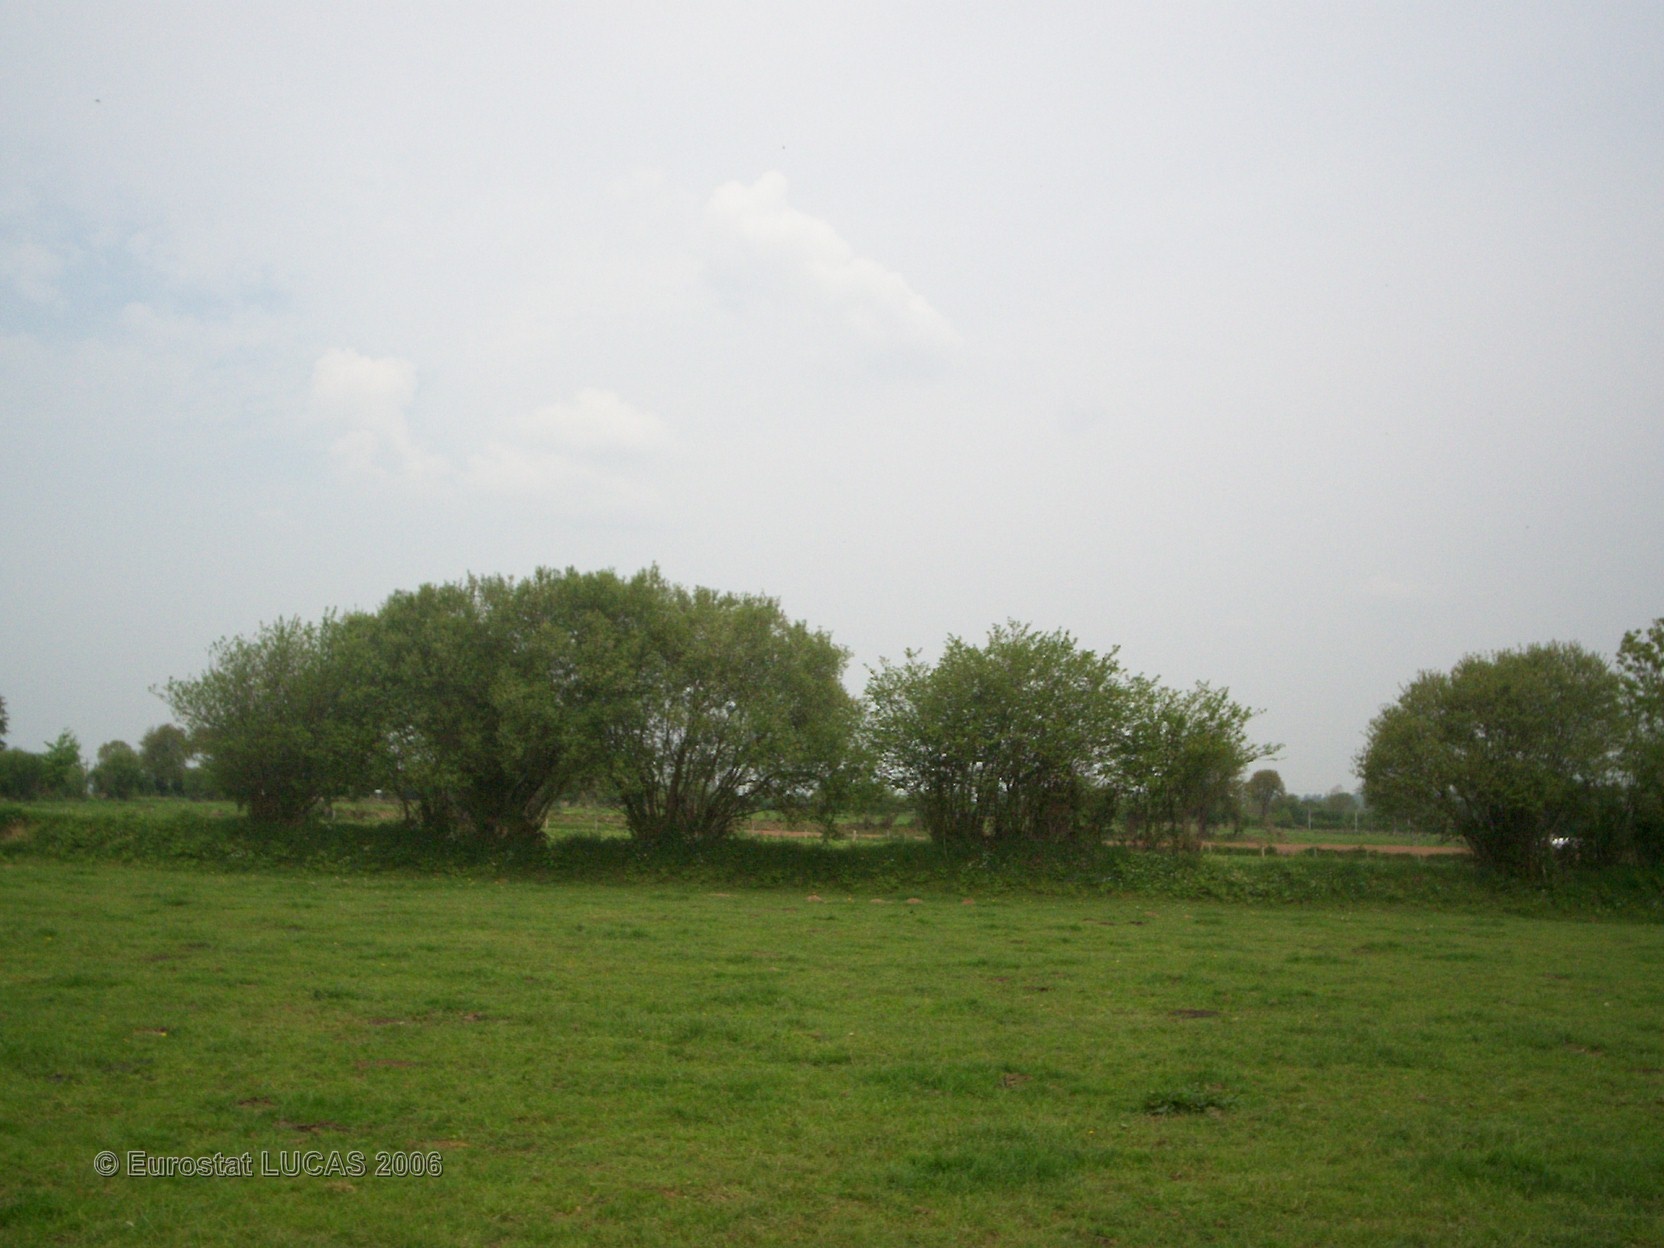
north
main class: Grassland
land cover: Grassland without tree/shrub cover
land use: Agriculture (excluding fallow land and kitchen gardens)
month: May
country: FR
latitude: 48.8503
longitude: -1.3712
